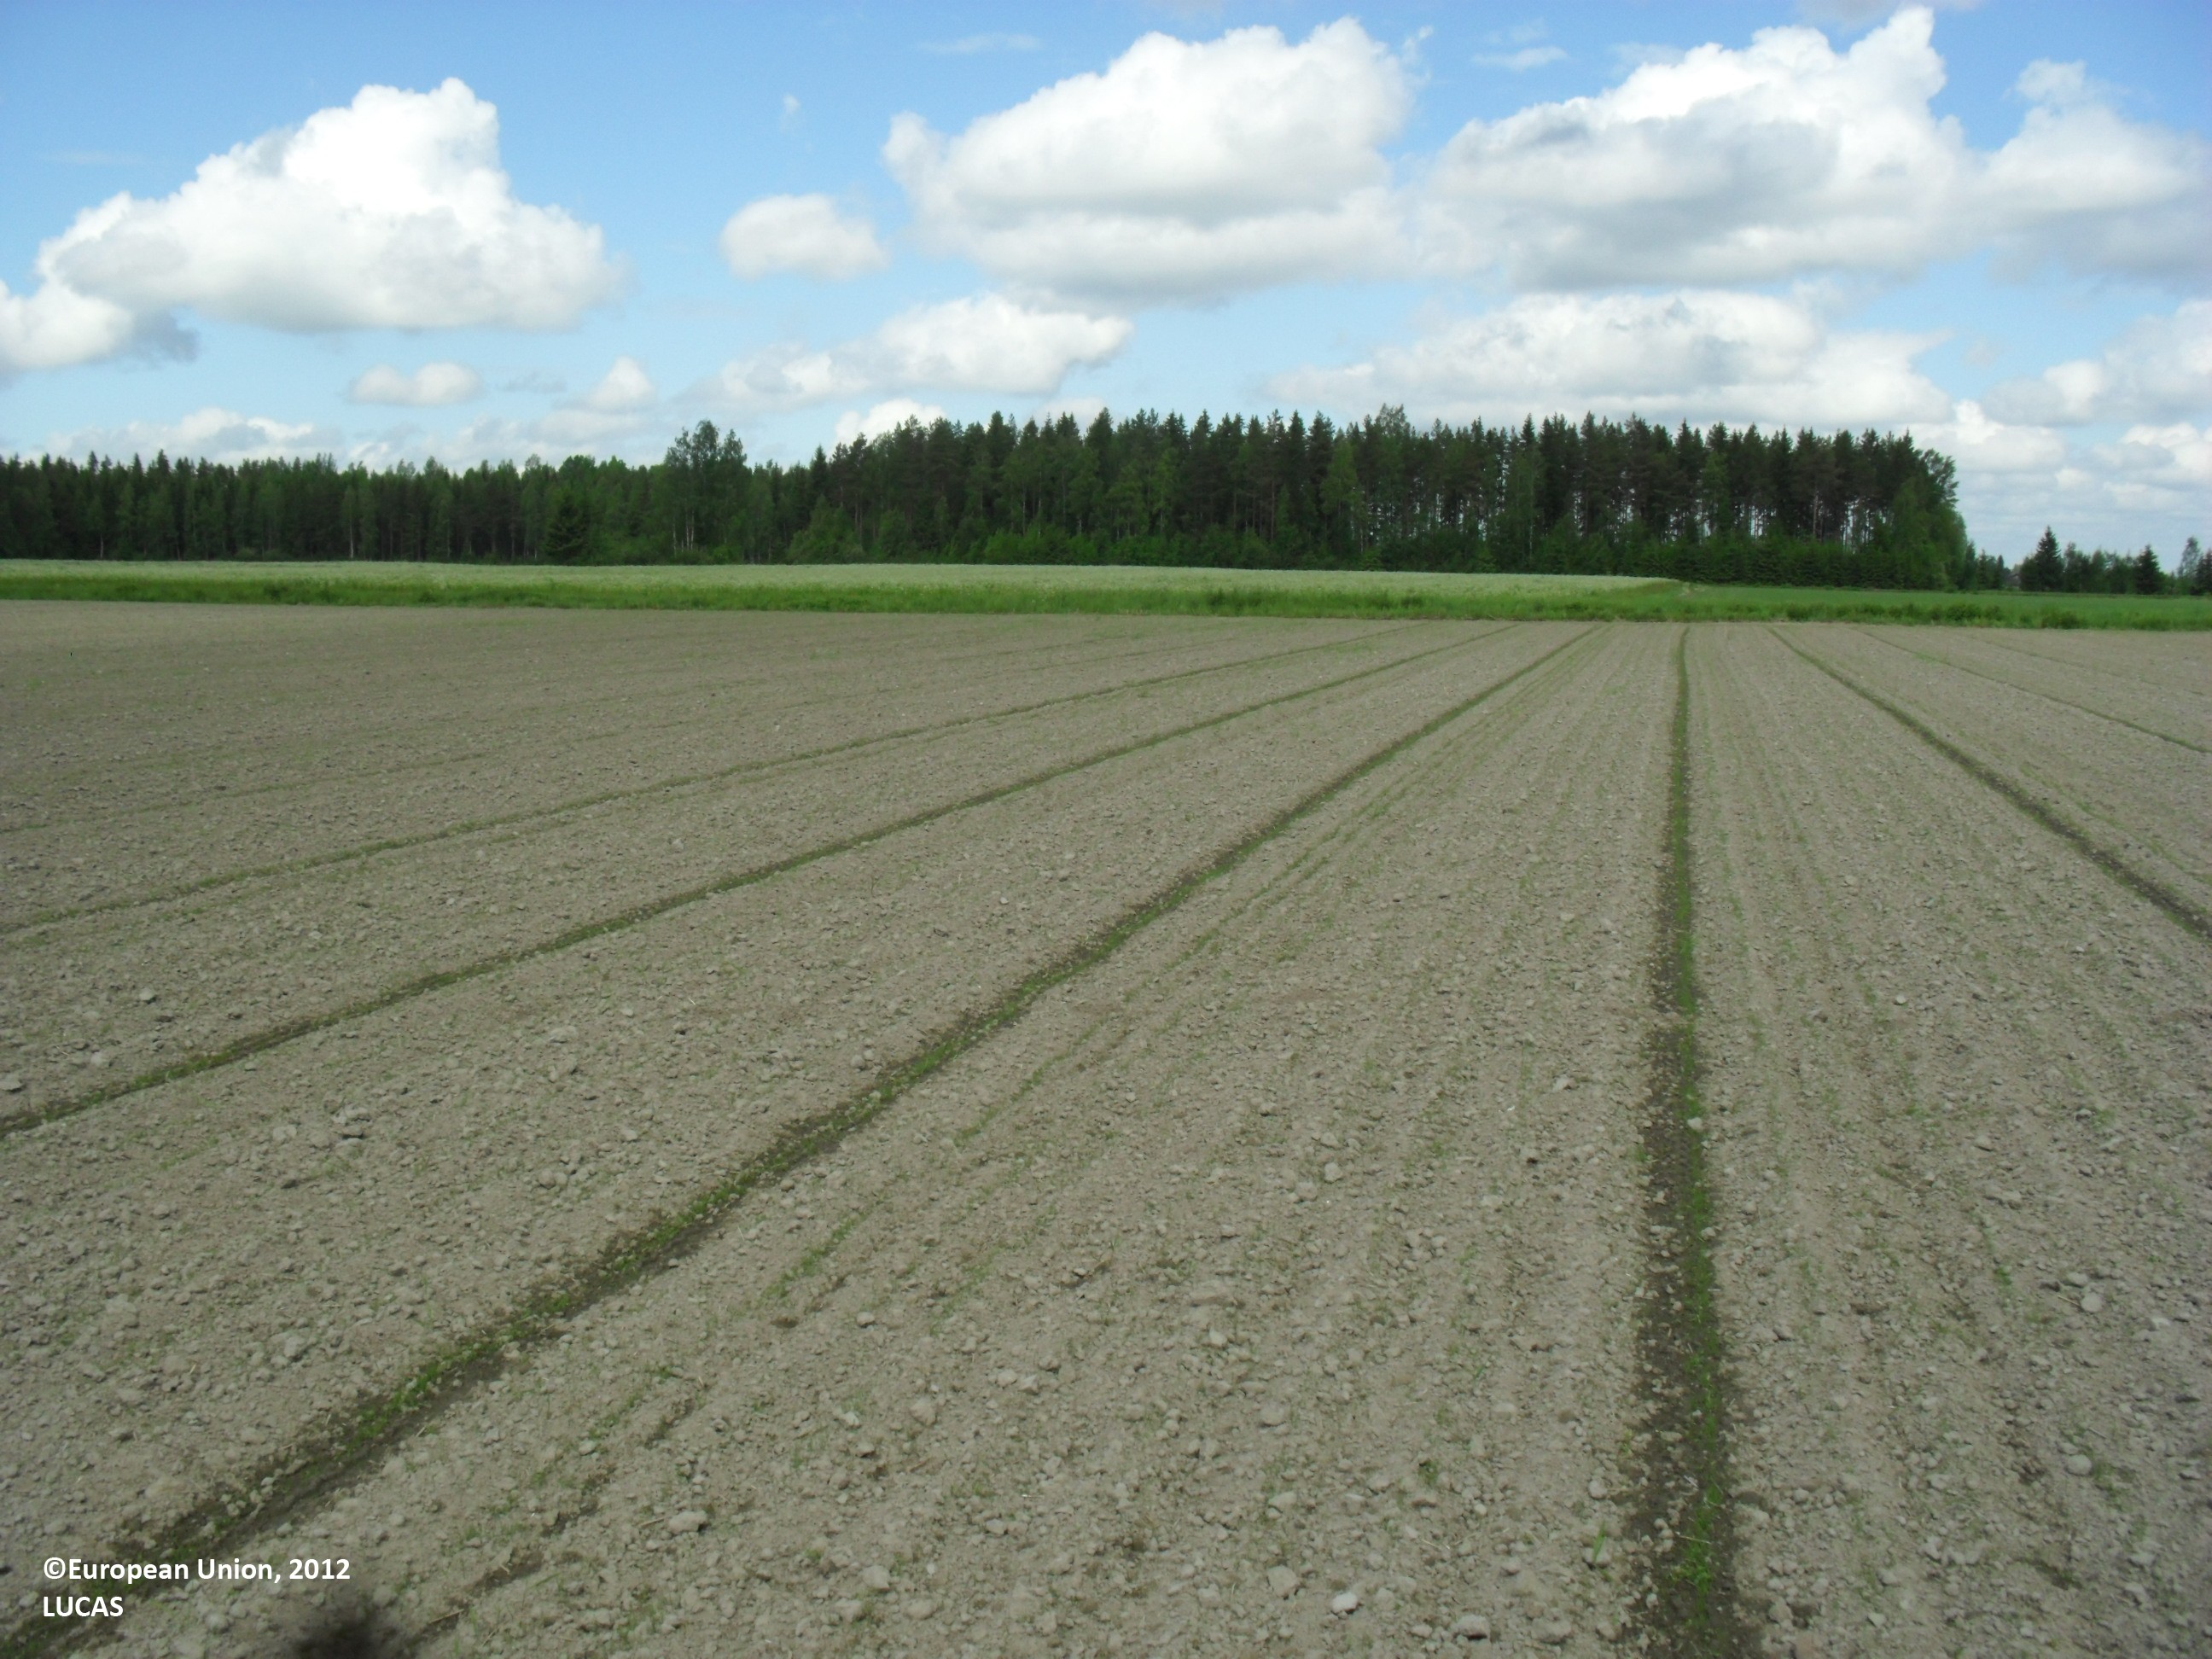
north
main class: Cropland
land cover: Temporary grasslands
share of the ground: < 10 %
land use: Agriculture (excluding fallow land and kitchen gardens)
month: June
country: FI
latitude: 62.7723
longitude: 23.4886
